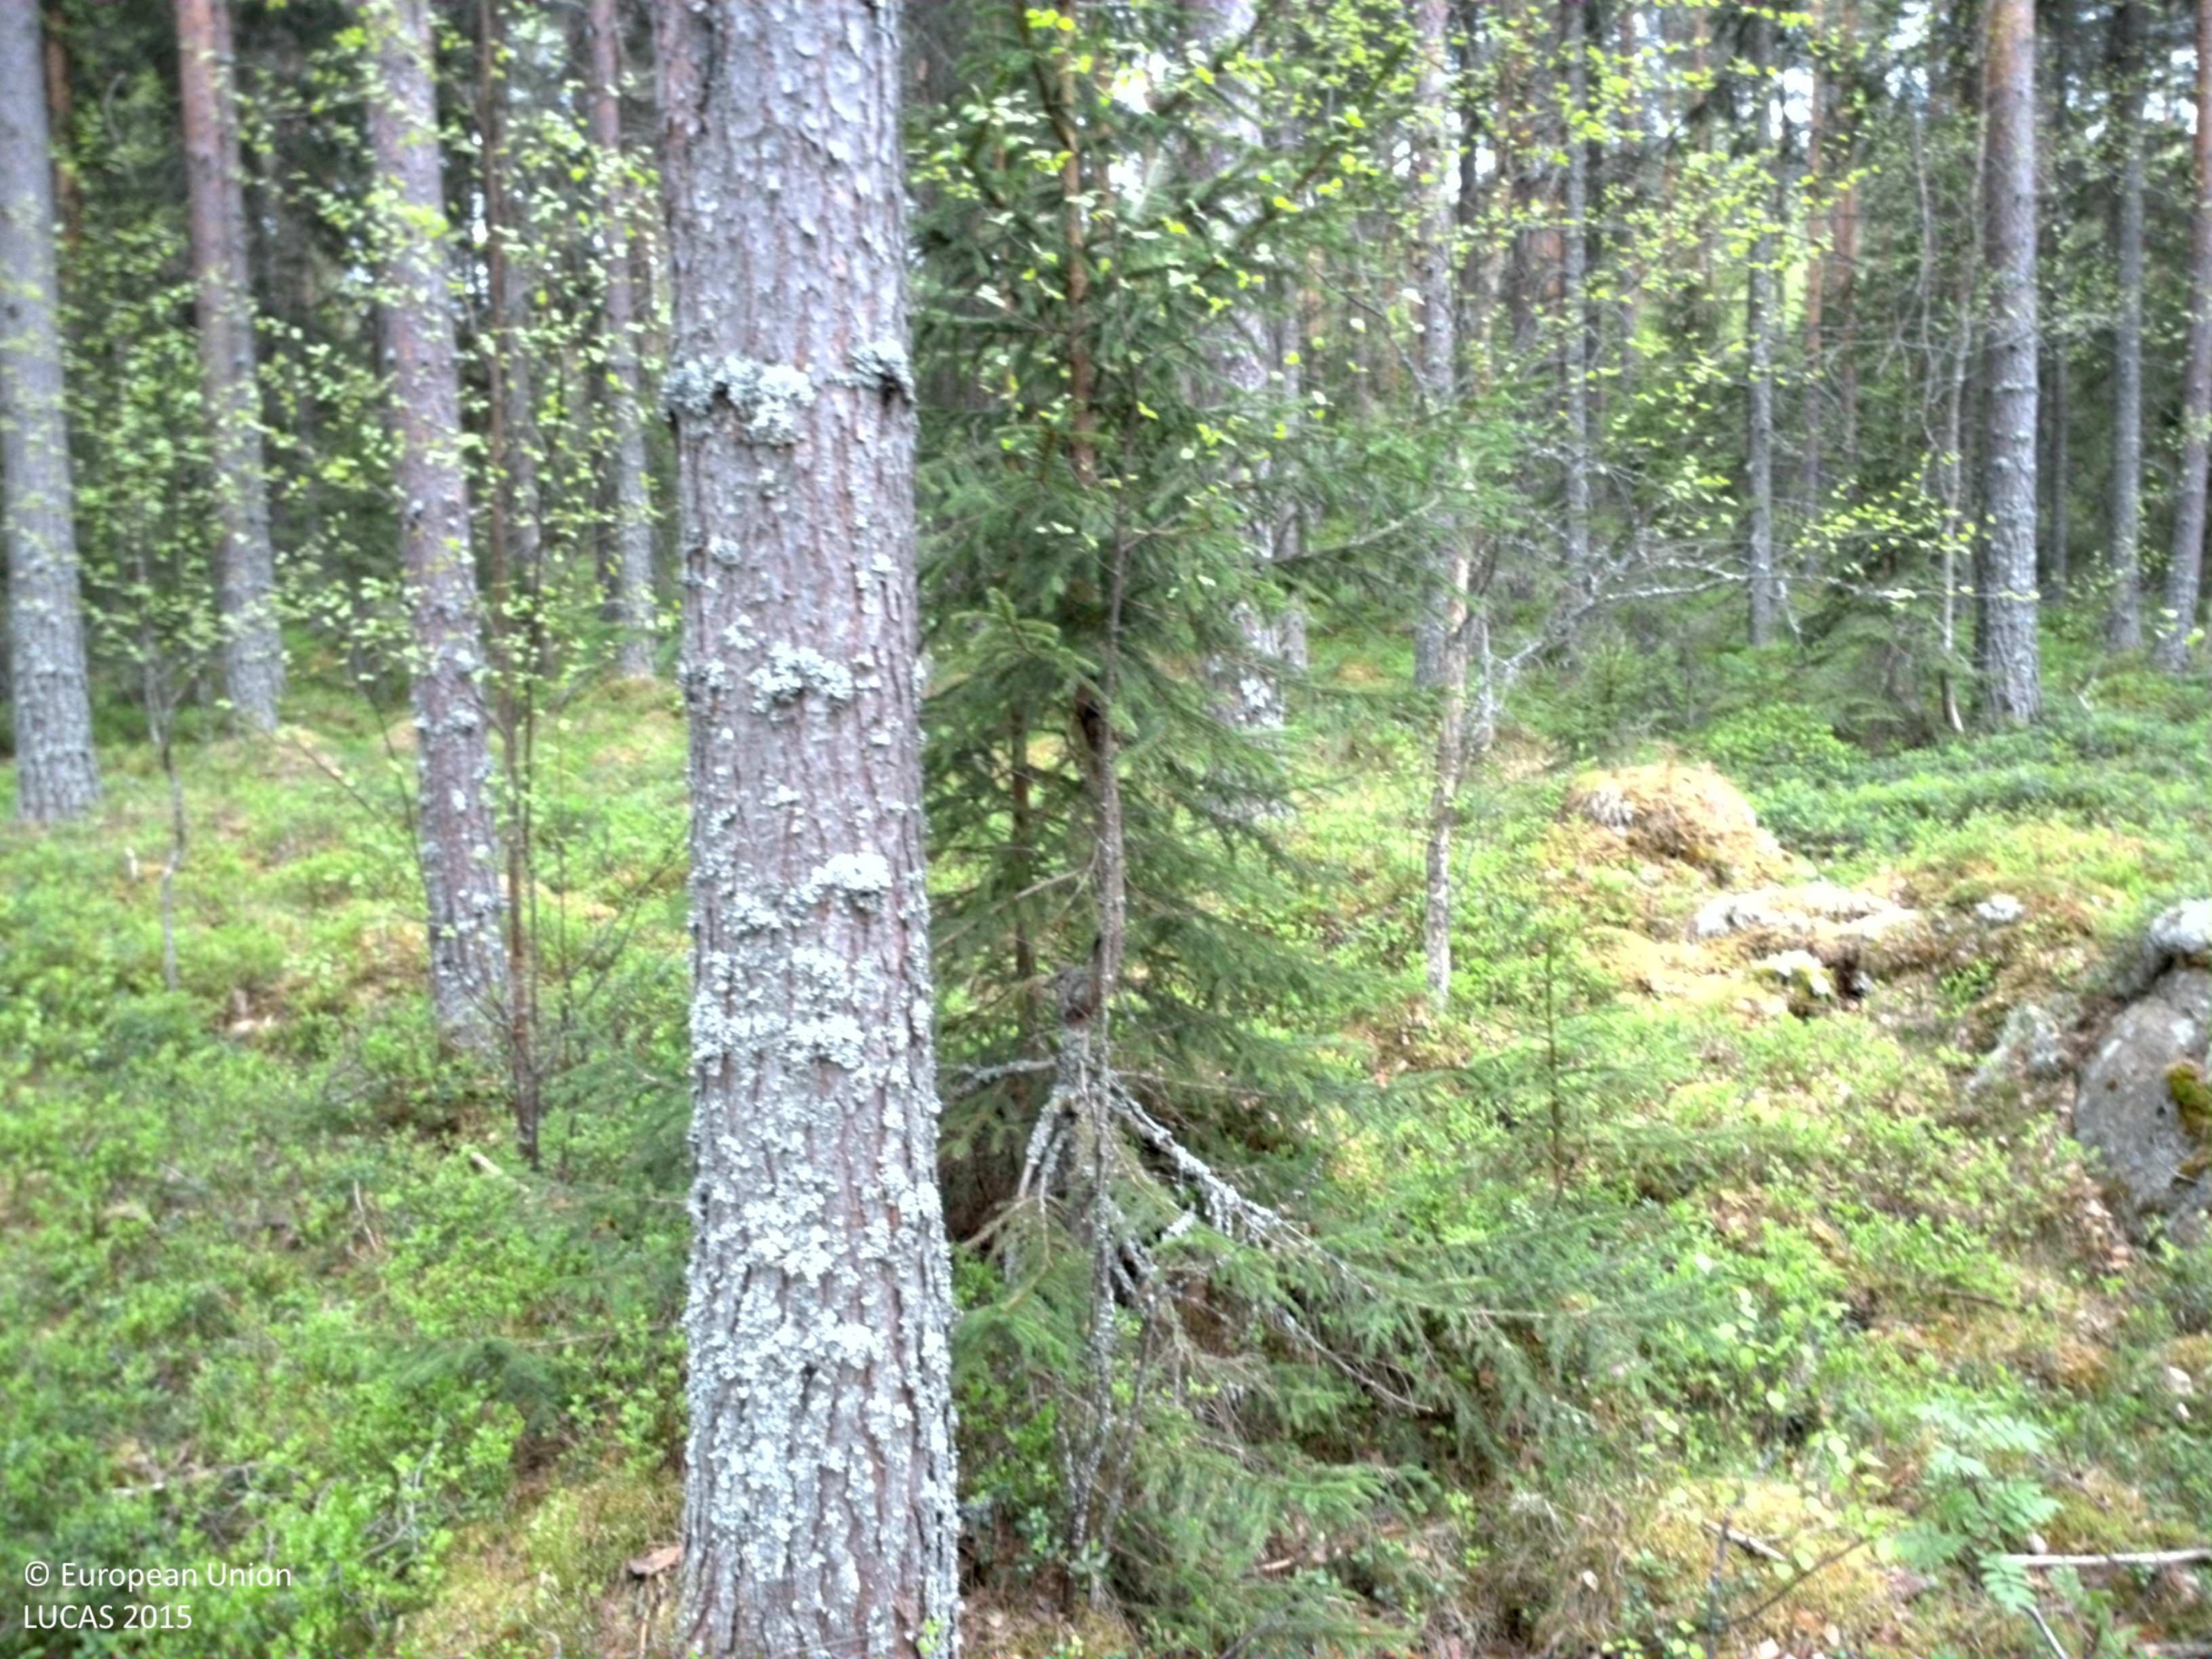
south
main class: Woodland
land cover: Pine dominated coniferous woodland
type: boreal forest
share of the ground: 50 - 75 %
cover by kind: coniferous forest trees 60 %, shrubs 30 %, broadleaved forest trees 10 %
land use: Forestry
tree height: > 5 m
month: May
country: SE
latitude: 61.1966
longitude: 15.3995
